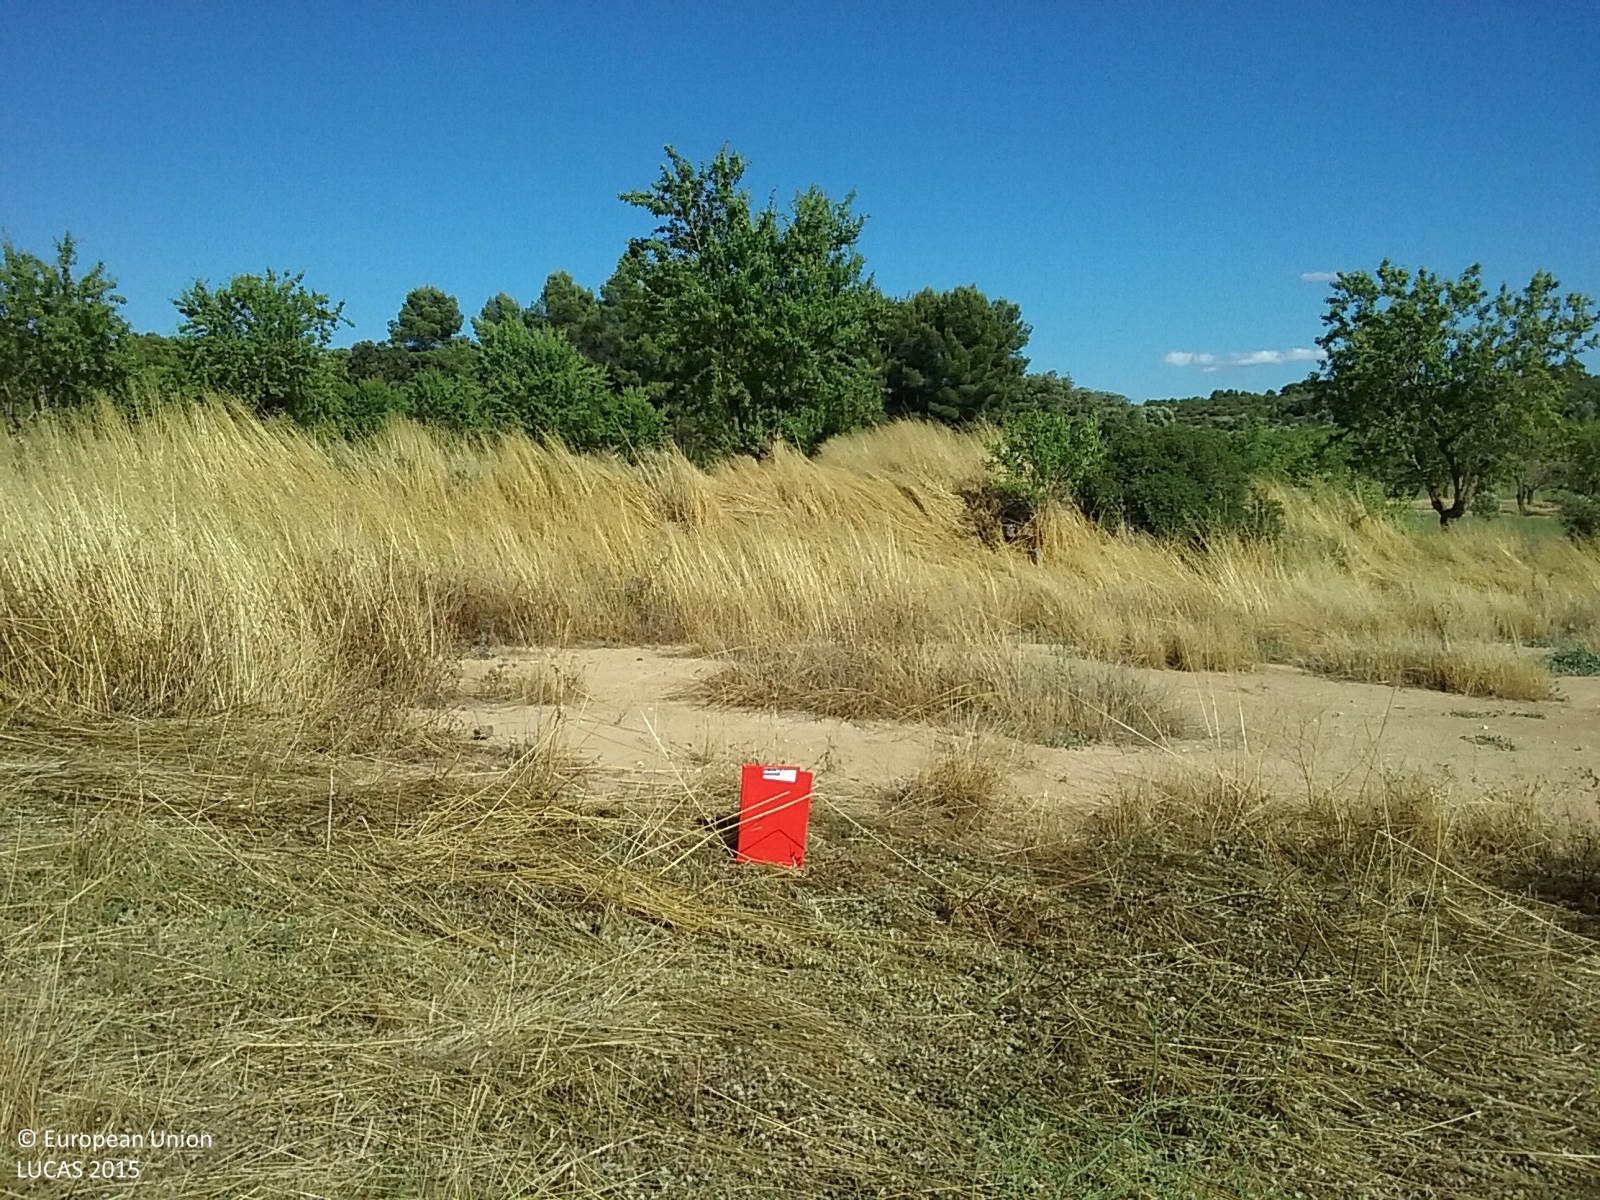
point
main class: Grassland
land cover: Grassland without tree/shrub cover
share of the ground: > 75 %
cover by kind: herbaceous plants 75 %, unconsolidated bare surface 25 %
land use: Abandoned areas
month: June
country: ES
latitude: 40.9938
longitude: 0.1837
